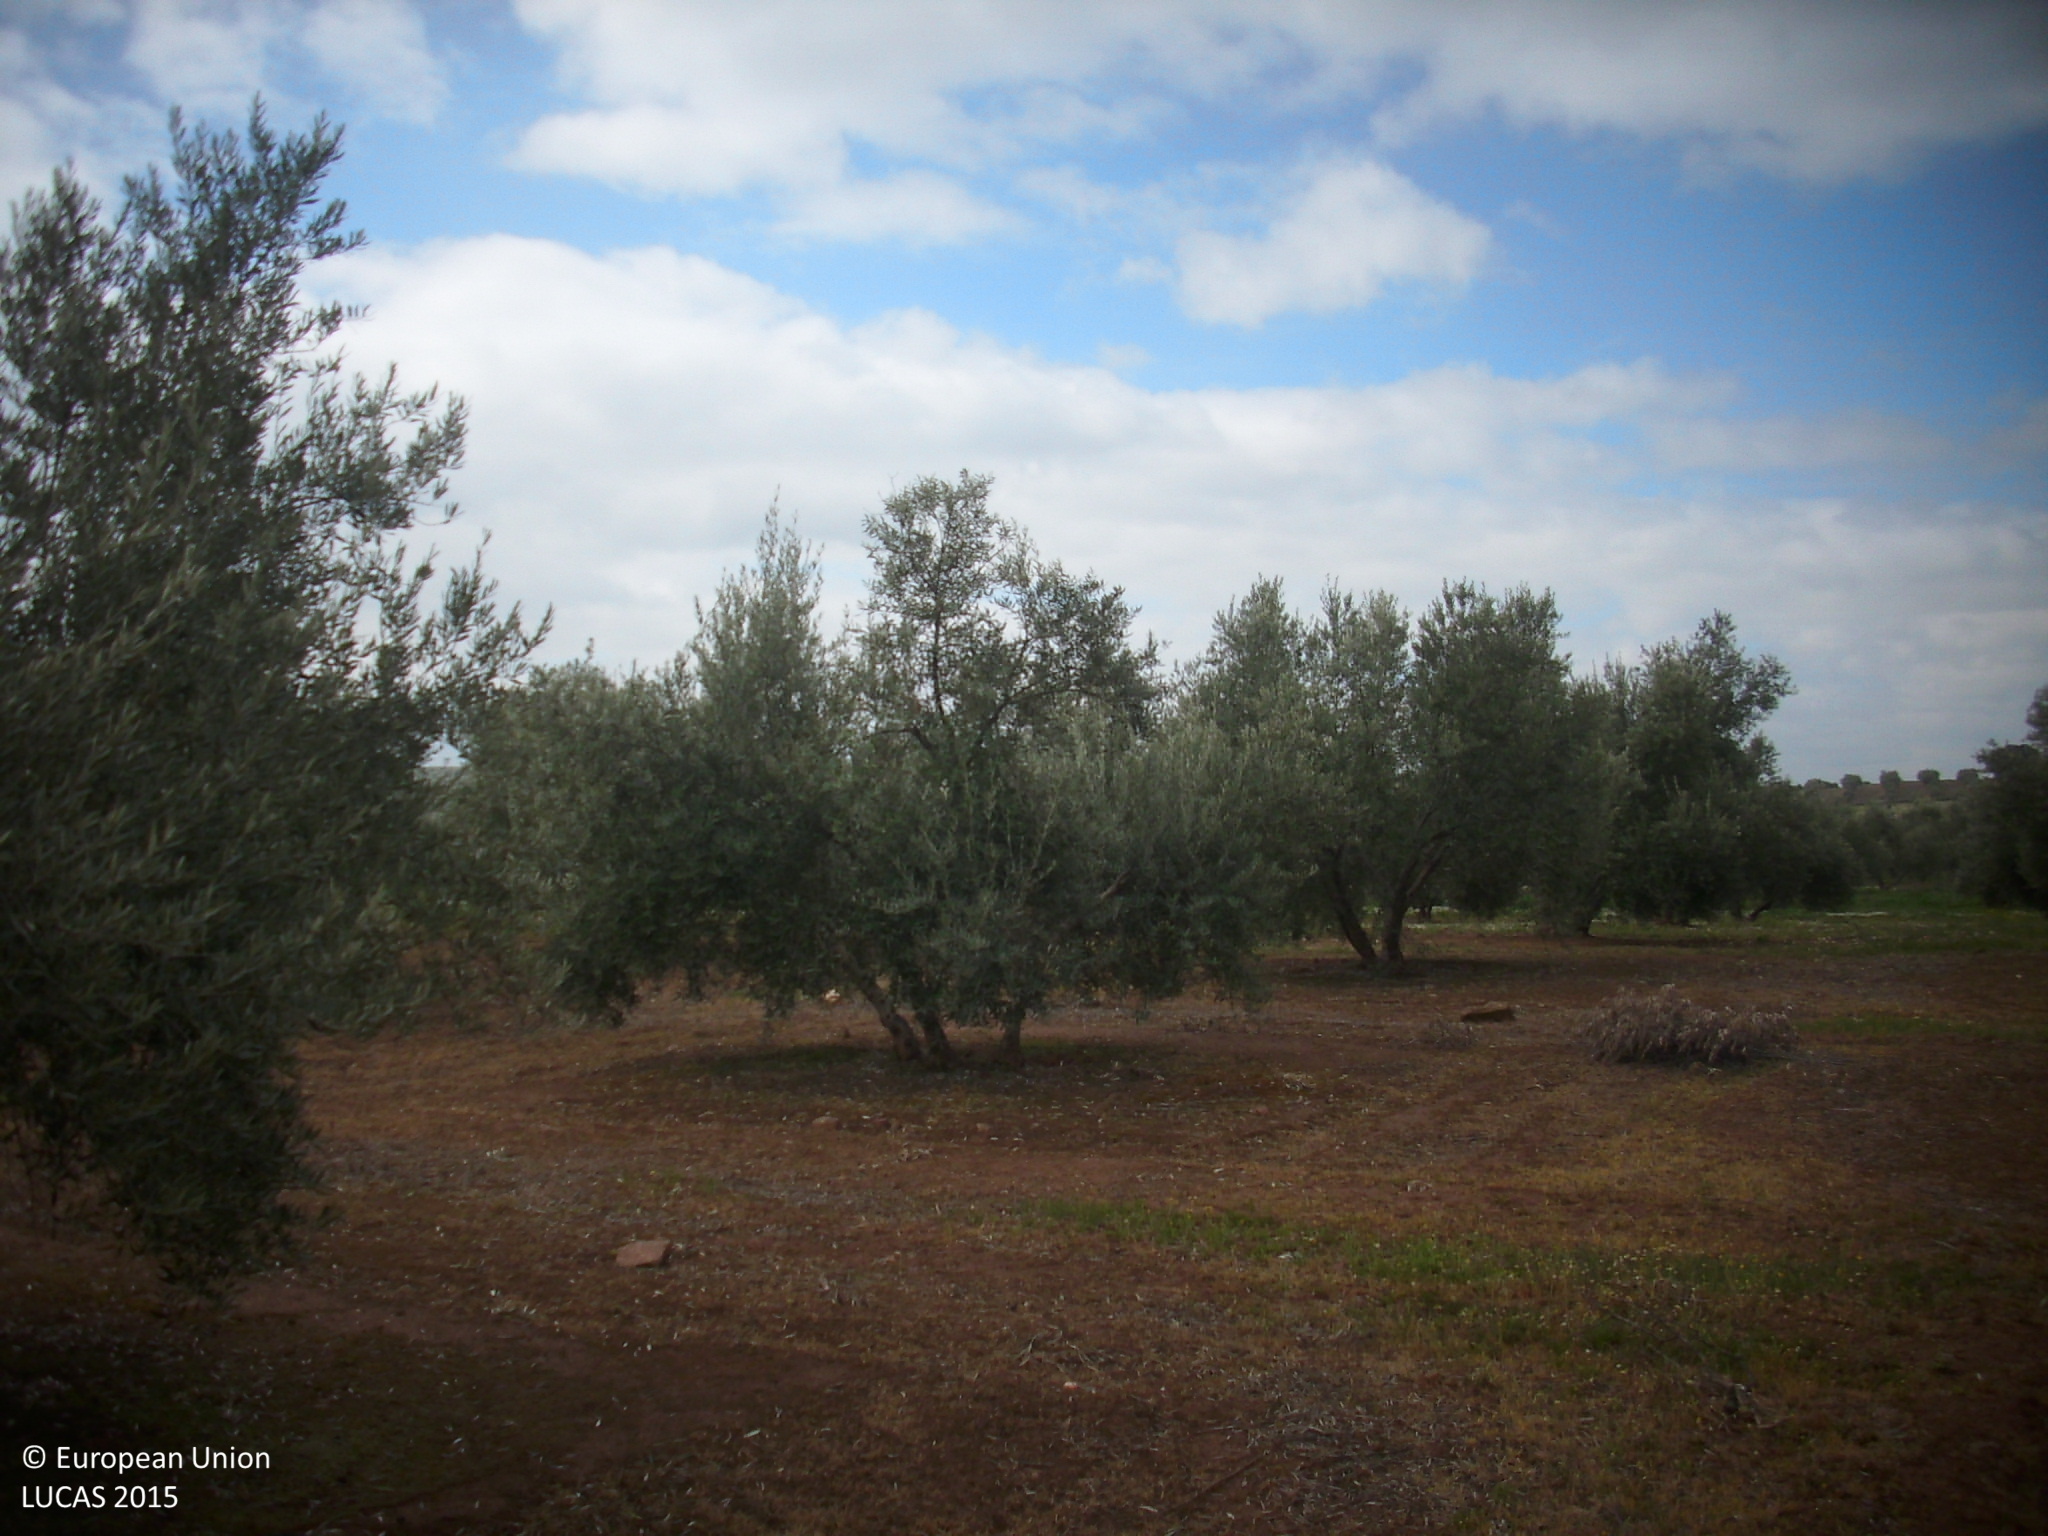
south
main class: Cropland
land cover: Olive groves
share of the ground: 25 - 50 %
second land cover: Spontaneously vegetated surfaces
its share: 50 - 75 %
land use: Agriculture (excluding fallow land and kitchen gardens)
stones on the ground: < 10 %
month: March
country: ES
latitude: 38.3195
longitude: -3.1213
